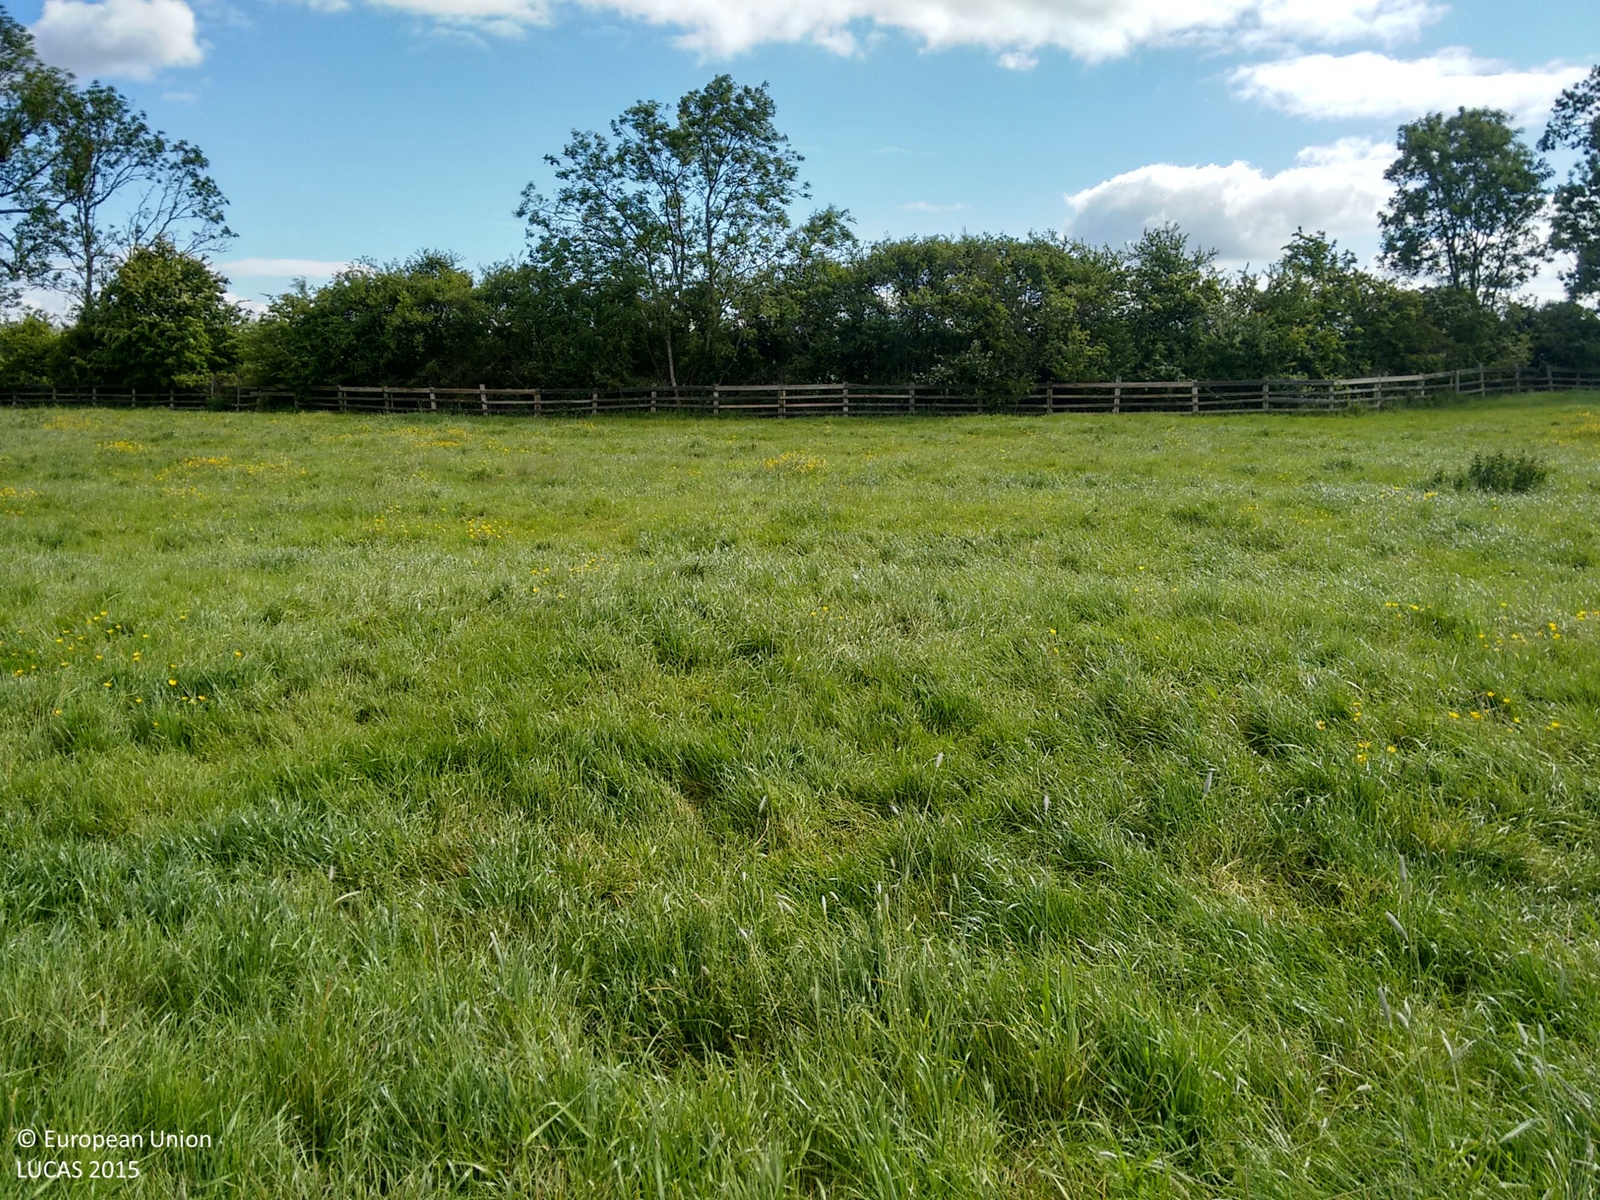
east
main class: Grassland
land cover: Grassland without tree/shrub cover
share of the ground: > 75 %
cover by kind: herbaceous plants 100 %
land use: Agriculture (excluding fallow land and kitchen gardens)
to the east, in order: Grassland without tree/shrub cover; Fences; Managed hedges; Grass margins; Common wheat
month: June
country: GB
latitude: 52.5182
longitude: -1.3819
